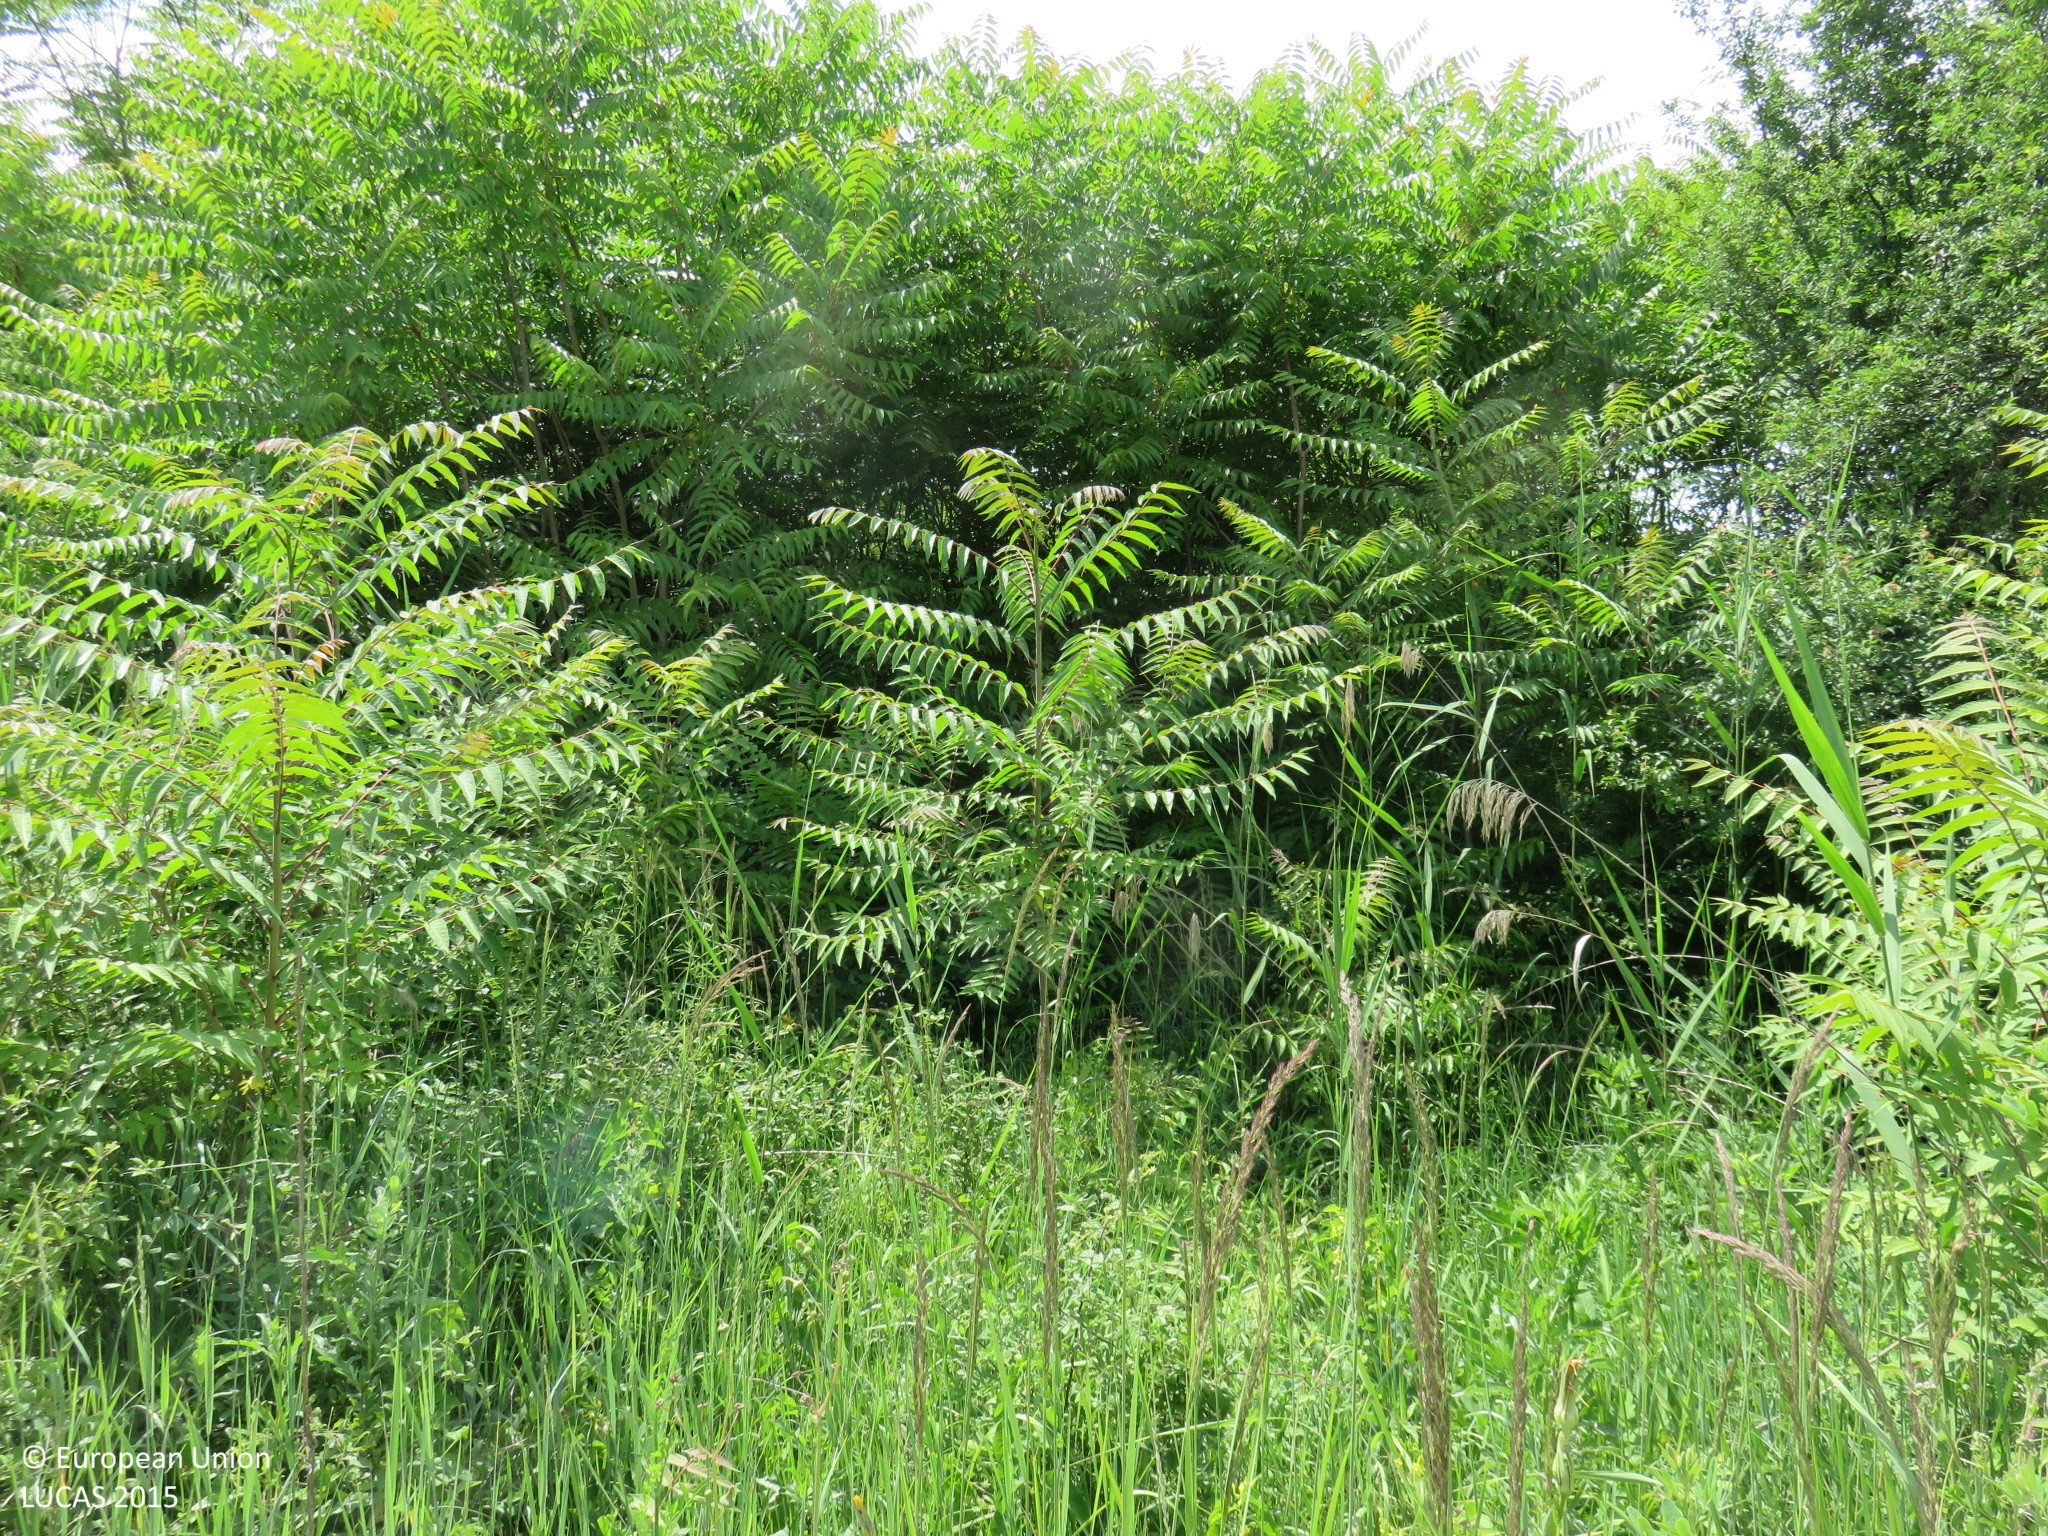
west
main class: Woodland
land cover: Broadleaved woodland
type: mesophytic deciduous forest
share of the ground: > 75 %
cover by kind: broadleaved forest trees 80 %, shrubs 15 %, herbaceous plants 5 %
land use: Semi-natural and natural areas not in use
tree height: < 5 m
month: June
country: BG
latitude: 43.3998
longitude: 24.4942
